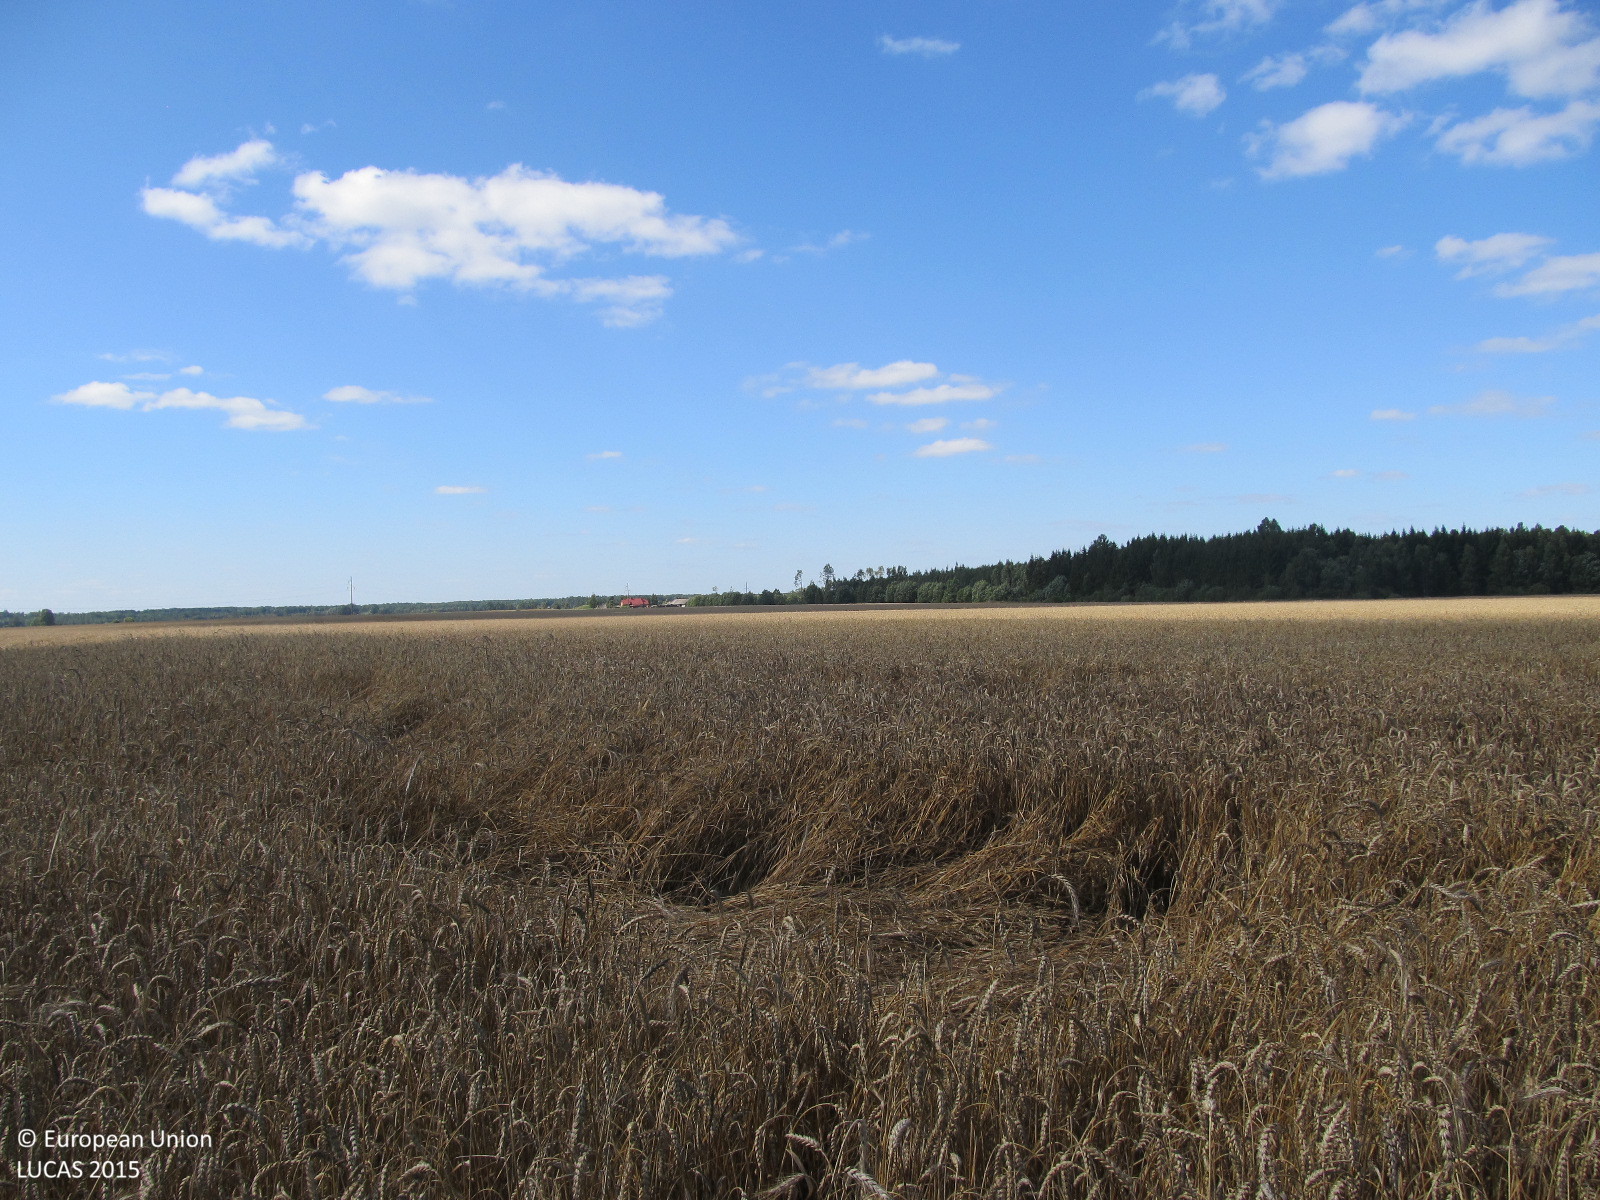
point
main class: Cropland
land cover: Common wheat
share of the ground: > 75 %
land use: Agriculture (excluding fallow land and kitchen gardens)
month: August
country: LT
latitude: 56.0829
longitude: 22.8724
